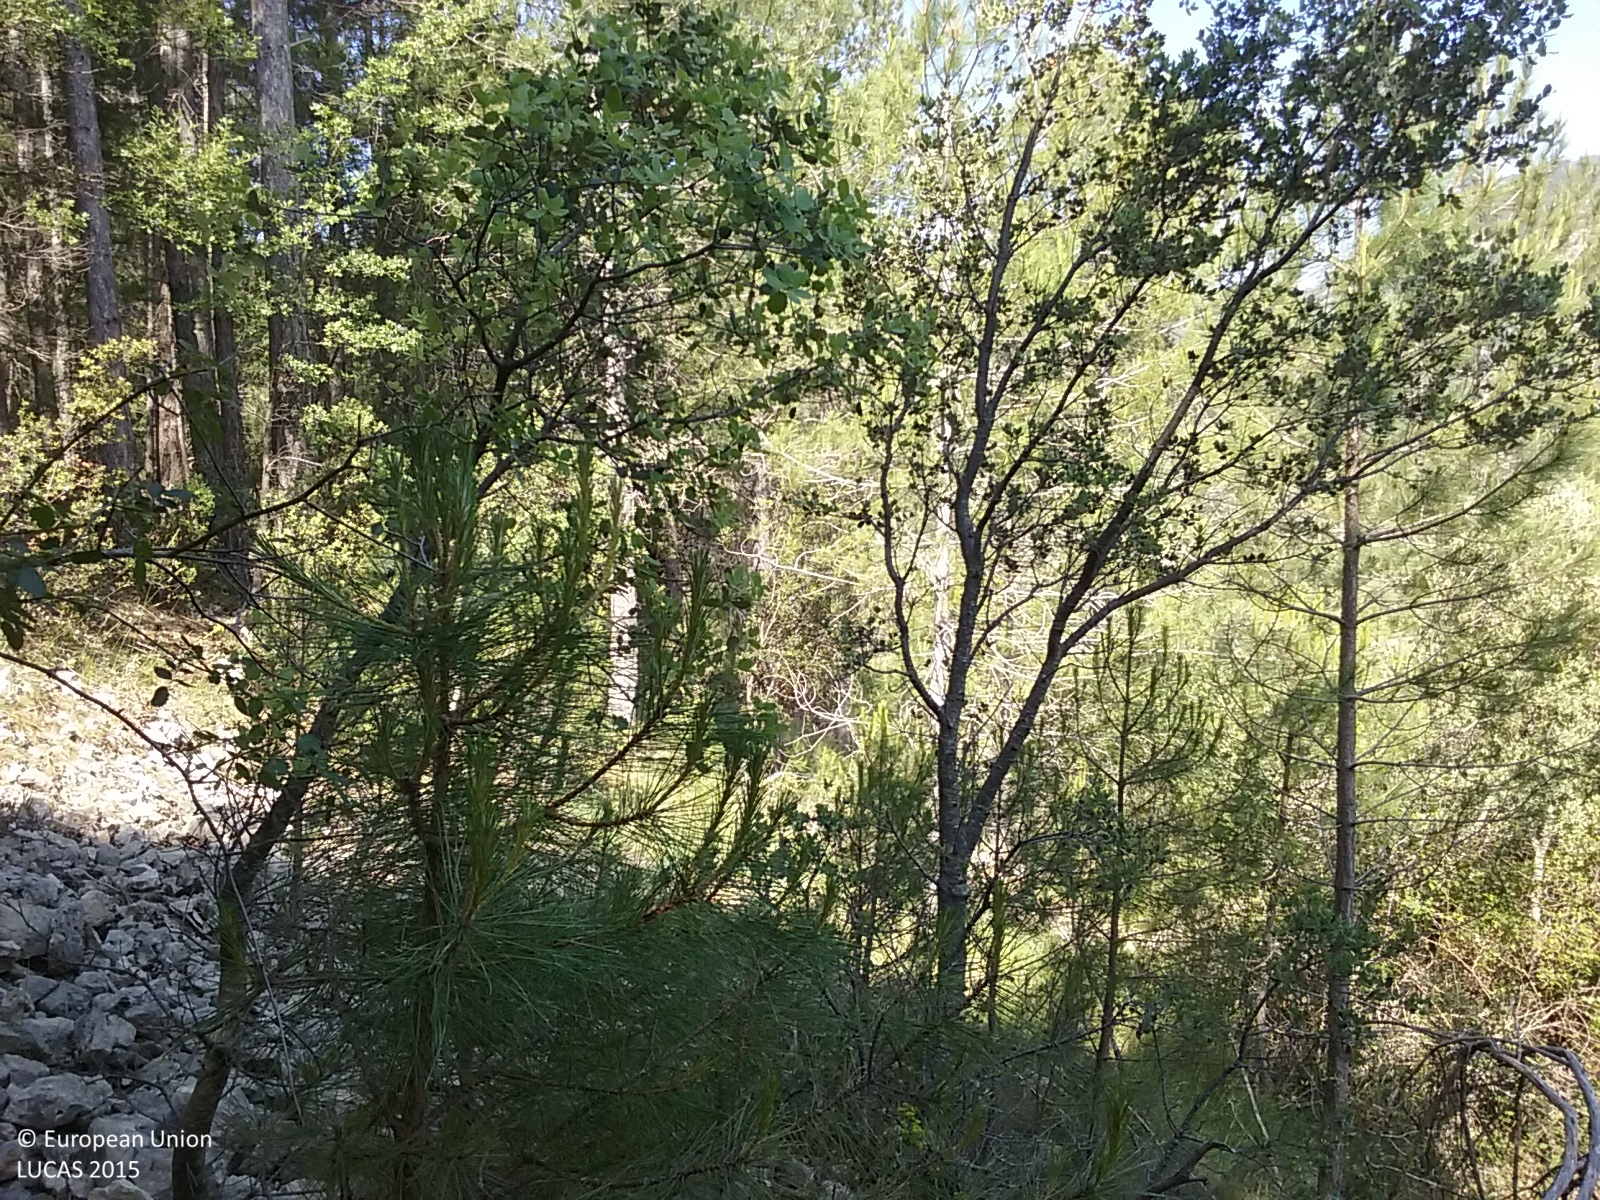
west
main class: Woodland
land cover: Pine dominated mixed woodland
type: coniferous forest of the mediterranean region
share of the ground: > 75 %
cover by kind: coniferous forest trees 45 %, broadleaved forest trees 35 %, herbaceous plants 10 %, shrubs 5 %, unconsolidated bare surface 5 %
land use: Forestry
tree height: > 5 m
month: June
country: ES
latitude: 40.7014
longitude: -0.0084
